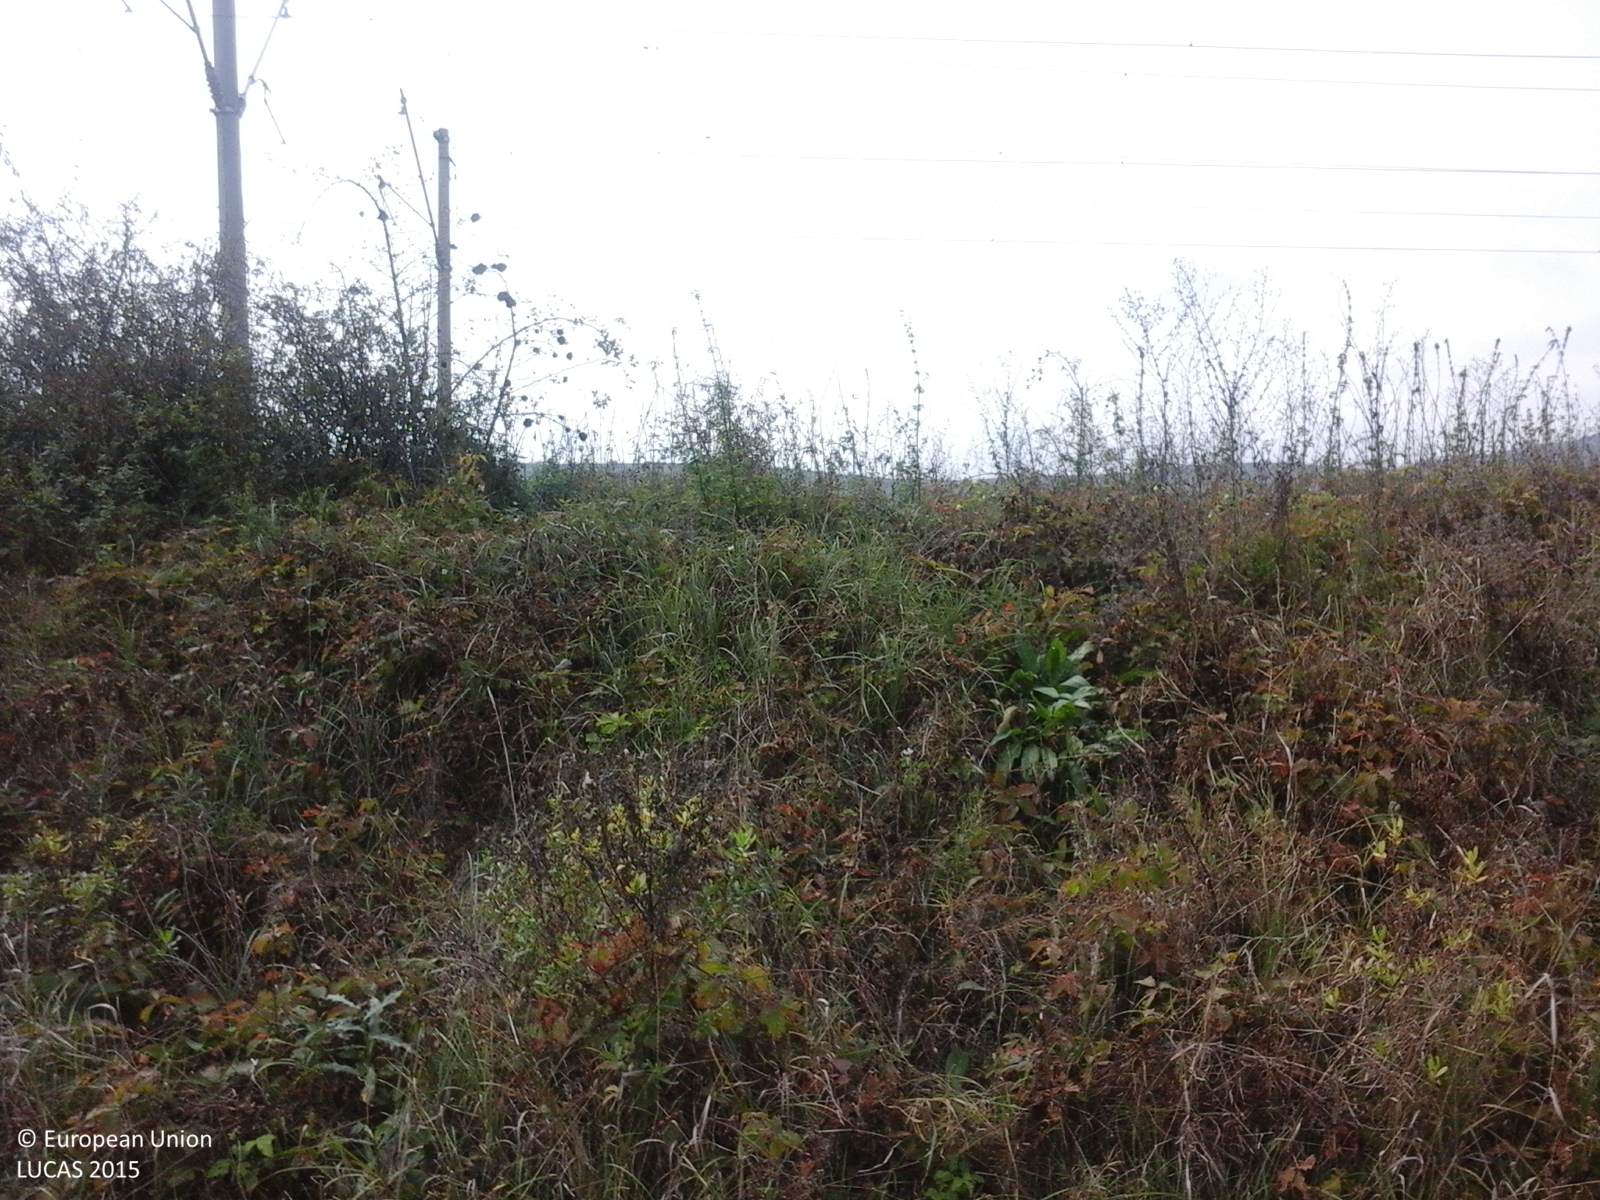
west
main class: Grassland
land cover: Grassland without tree/shrub cover
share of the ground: > 75 %
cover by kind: herbaceous plants 100 %
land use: Agriculture (excluding fallow land and kitchen gardens)
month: October
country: RO
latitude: 46.0892
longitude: 25.2711
